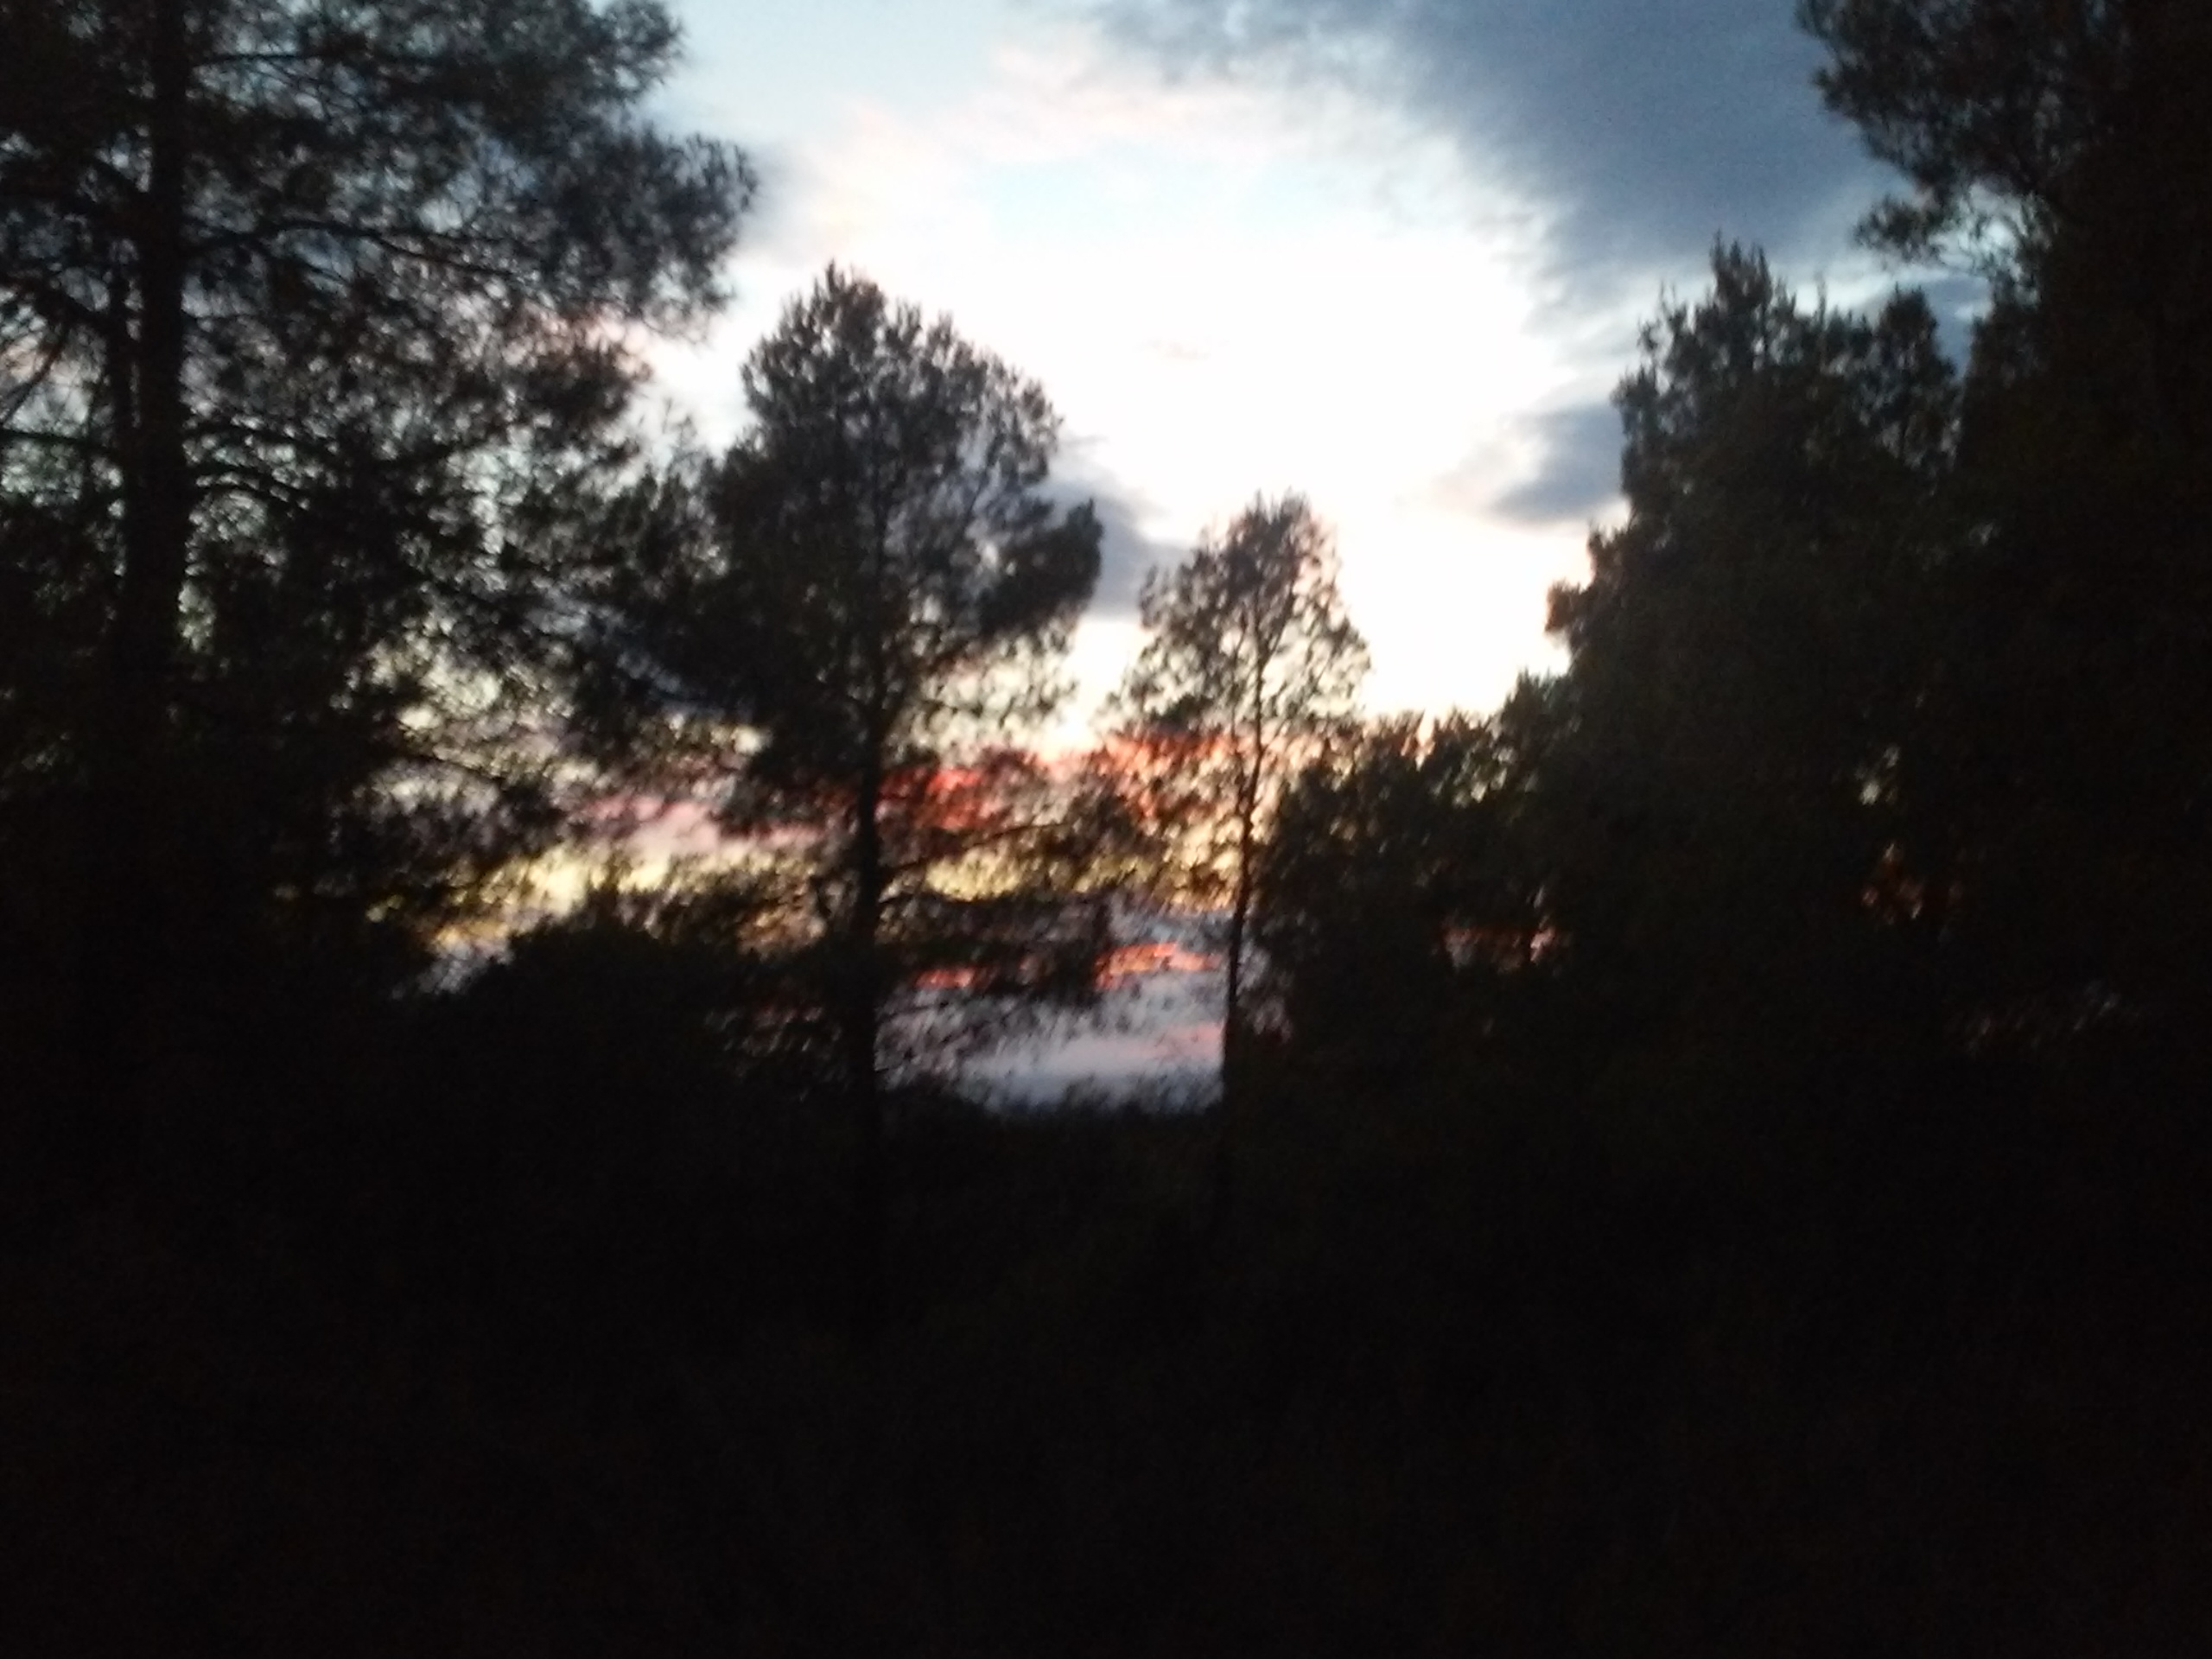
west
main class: Woodland
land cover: Pine dominated coniferous woodland
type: coniferous forest of the mediterranean region
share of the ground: 10 - 25 %
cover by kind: consolidated bare surface 30 %, shrubs 25 %, coniferous forest trees 20 %, herbaceous plants 20 %, broadleaved forest trees 5 %
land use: Semi-natural and natural areas not in use
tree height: < 5 m
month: August
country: ES
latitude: 41.4136
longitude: 0.7660
